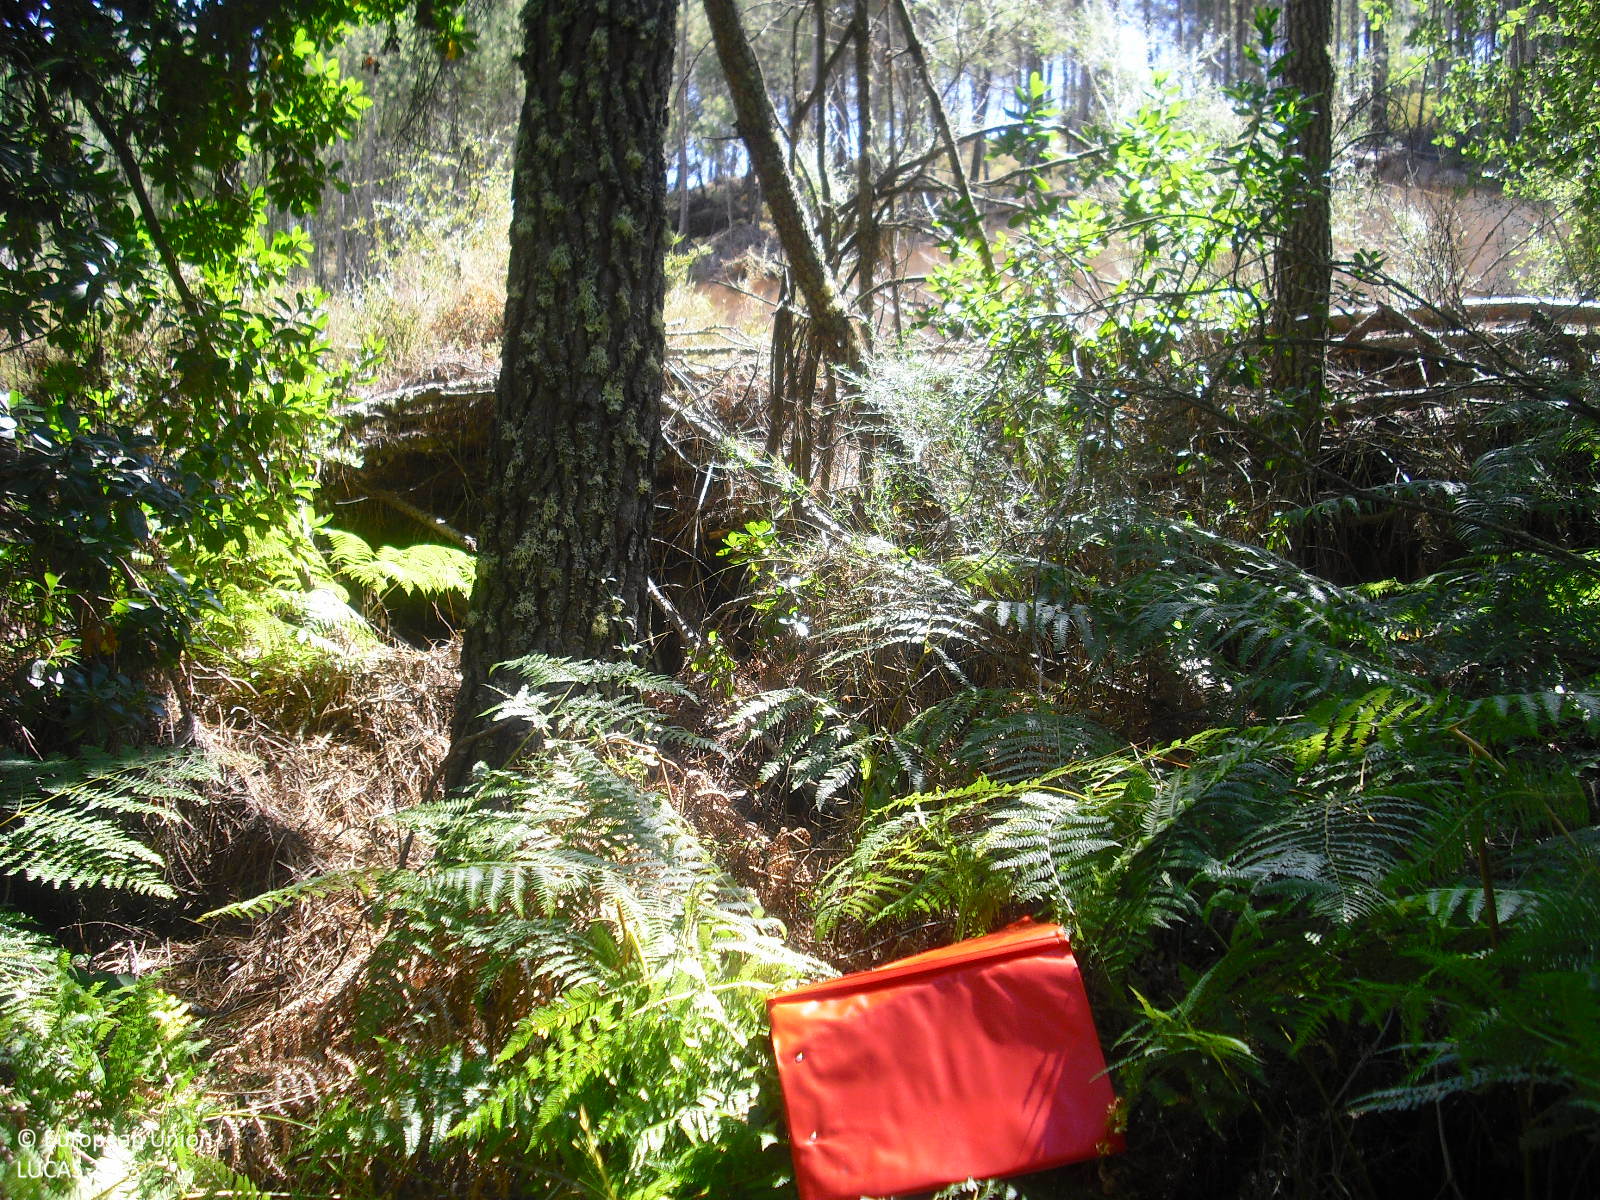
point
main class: Woodland
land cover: Pine dominated mixed woodland
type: hemiboreal forest and nemoral coniferous forest and mixed broadleaved-coniferous forest
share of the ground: 25 - 50 %
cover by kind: shrubs 40 %, coniferous forest trees 30 %, unconsolidated bare surface 20 %, broadleaved forest trees 10 %
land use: Forestry
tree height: > 5 m
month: August
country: ES
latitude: 42.3940
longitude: -7.1507
